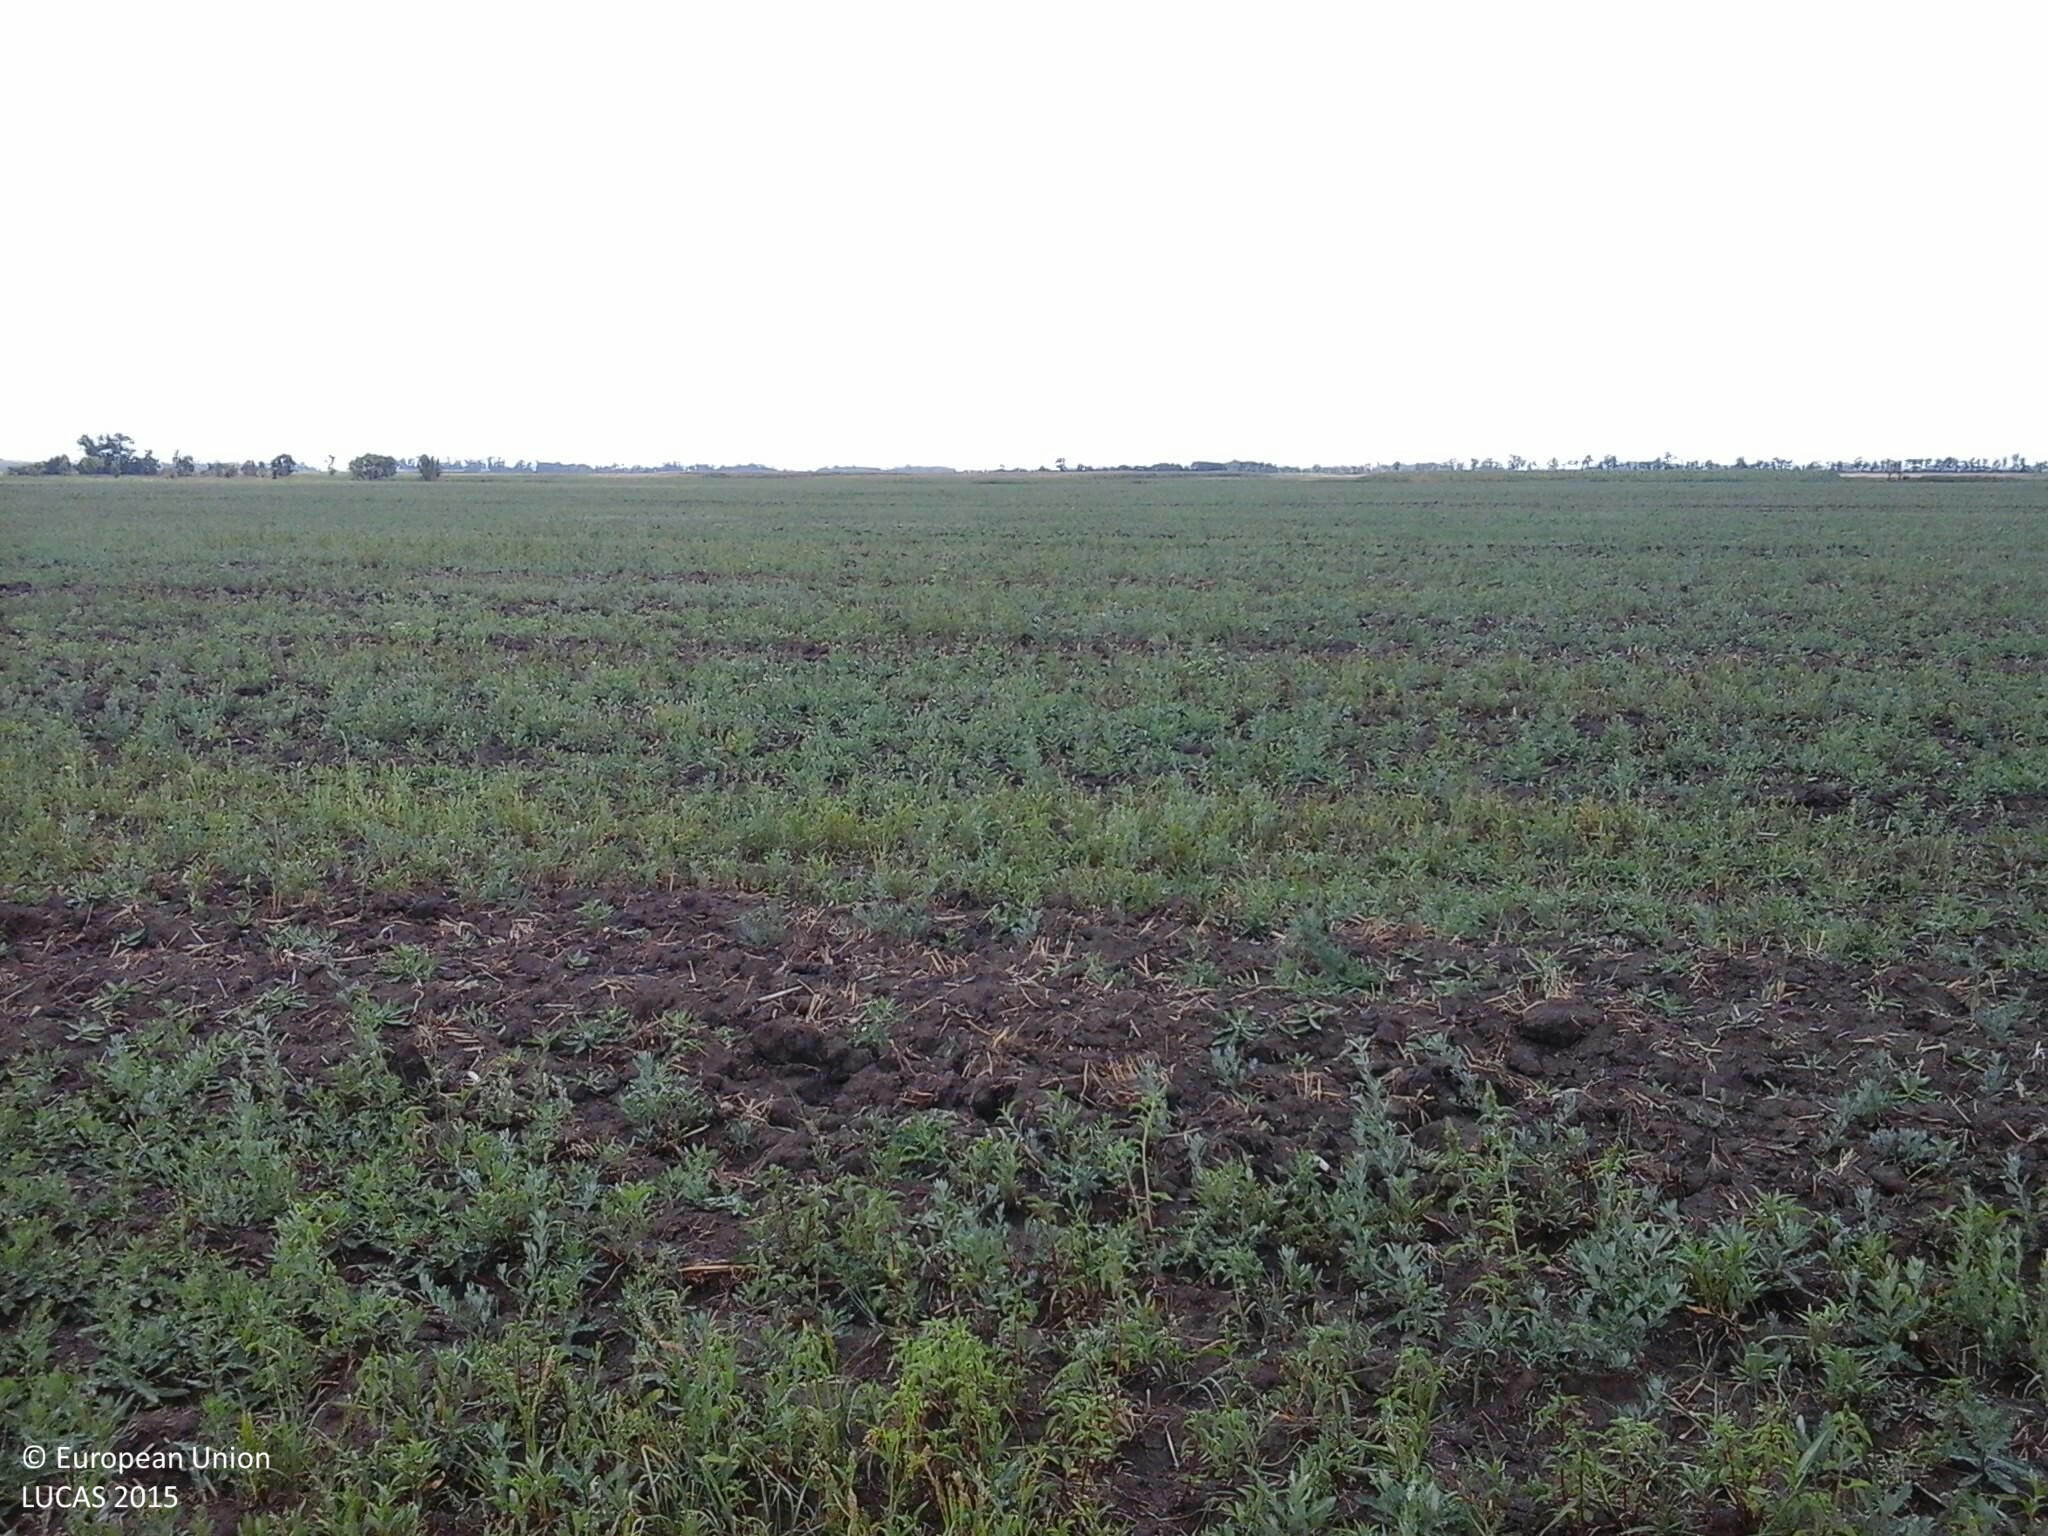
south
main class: Grassland
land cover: Spontaneously vegetated surfaces
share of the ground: 50 - 75 %
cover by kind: herbaceous plants 60 %, unconsolidated bare surface 40 %
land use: Fallow land
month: August
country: HU
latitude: 47.6030
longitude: 20.9569
